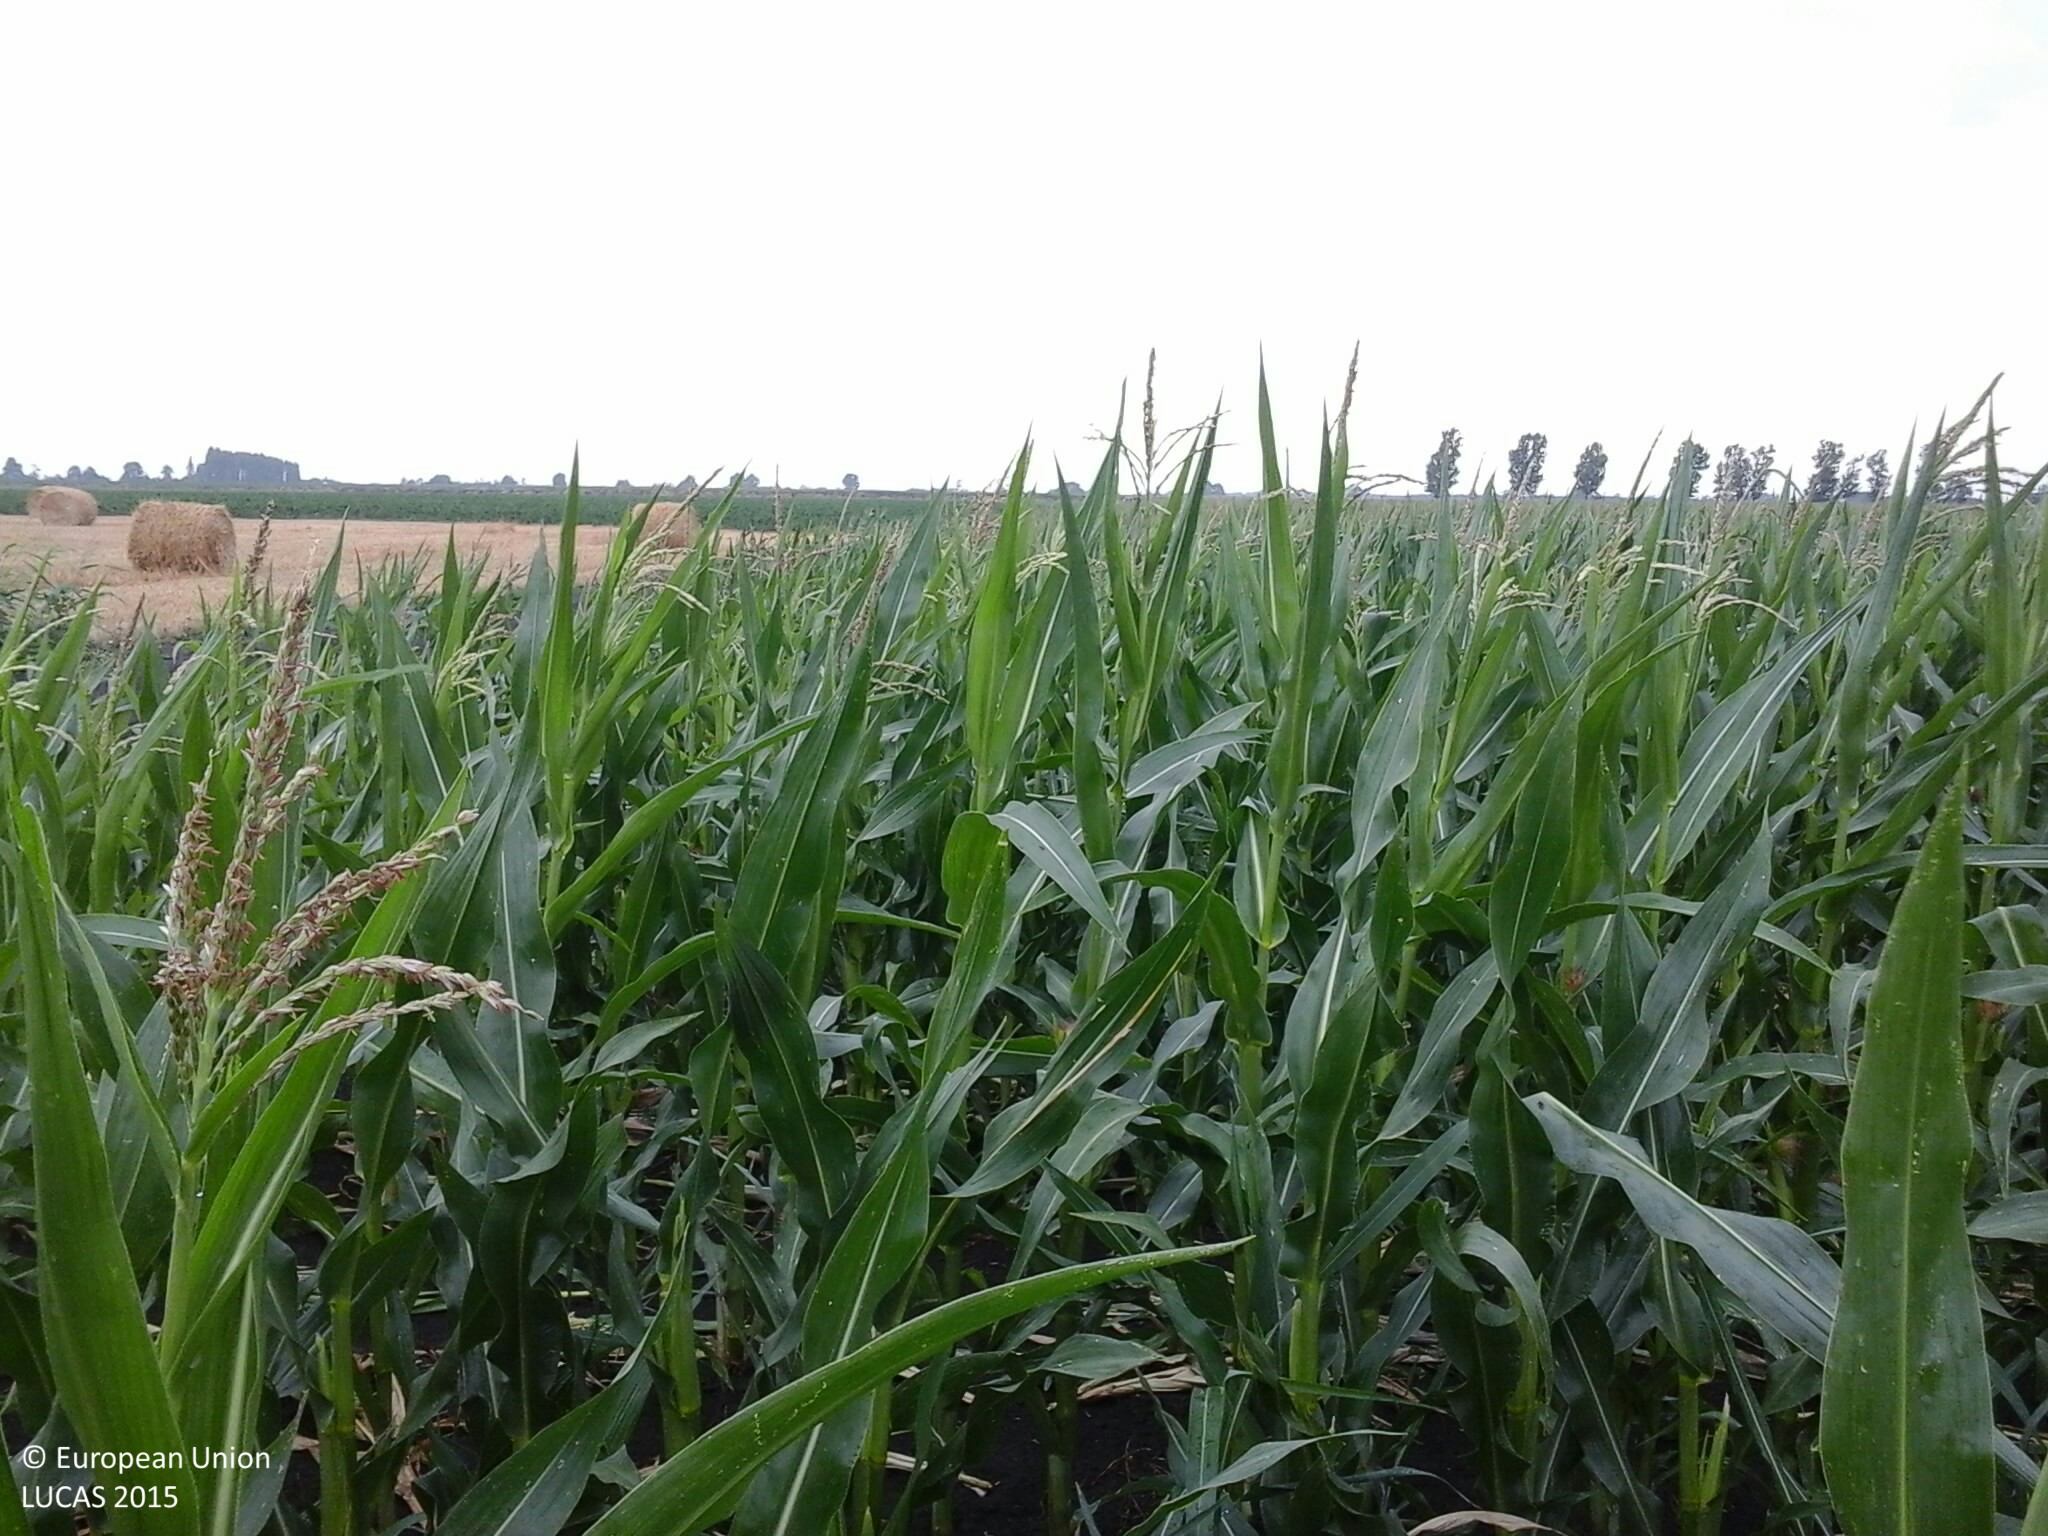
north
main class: Cropland
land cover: Maize
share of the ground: > 75 %
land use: Agriculture (excluding fallow land and kitchen gardens)
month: July
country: HU
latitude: 46.9760
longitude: 20.3196
